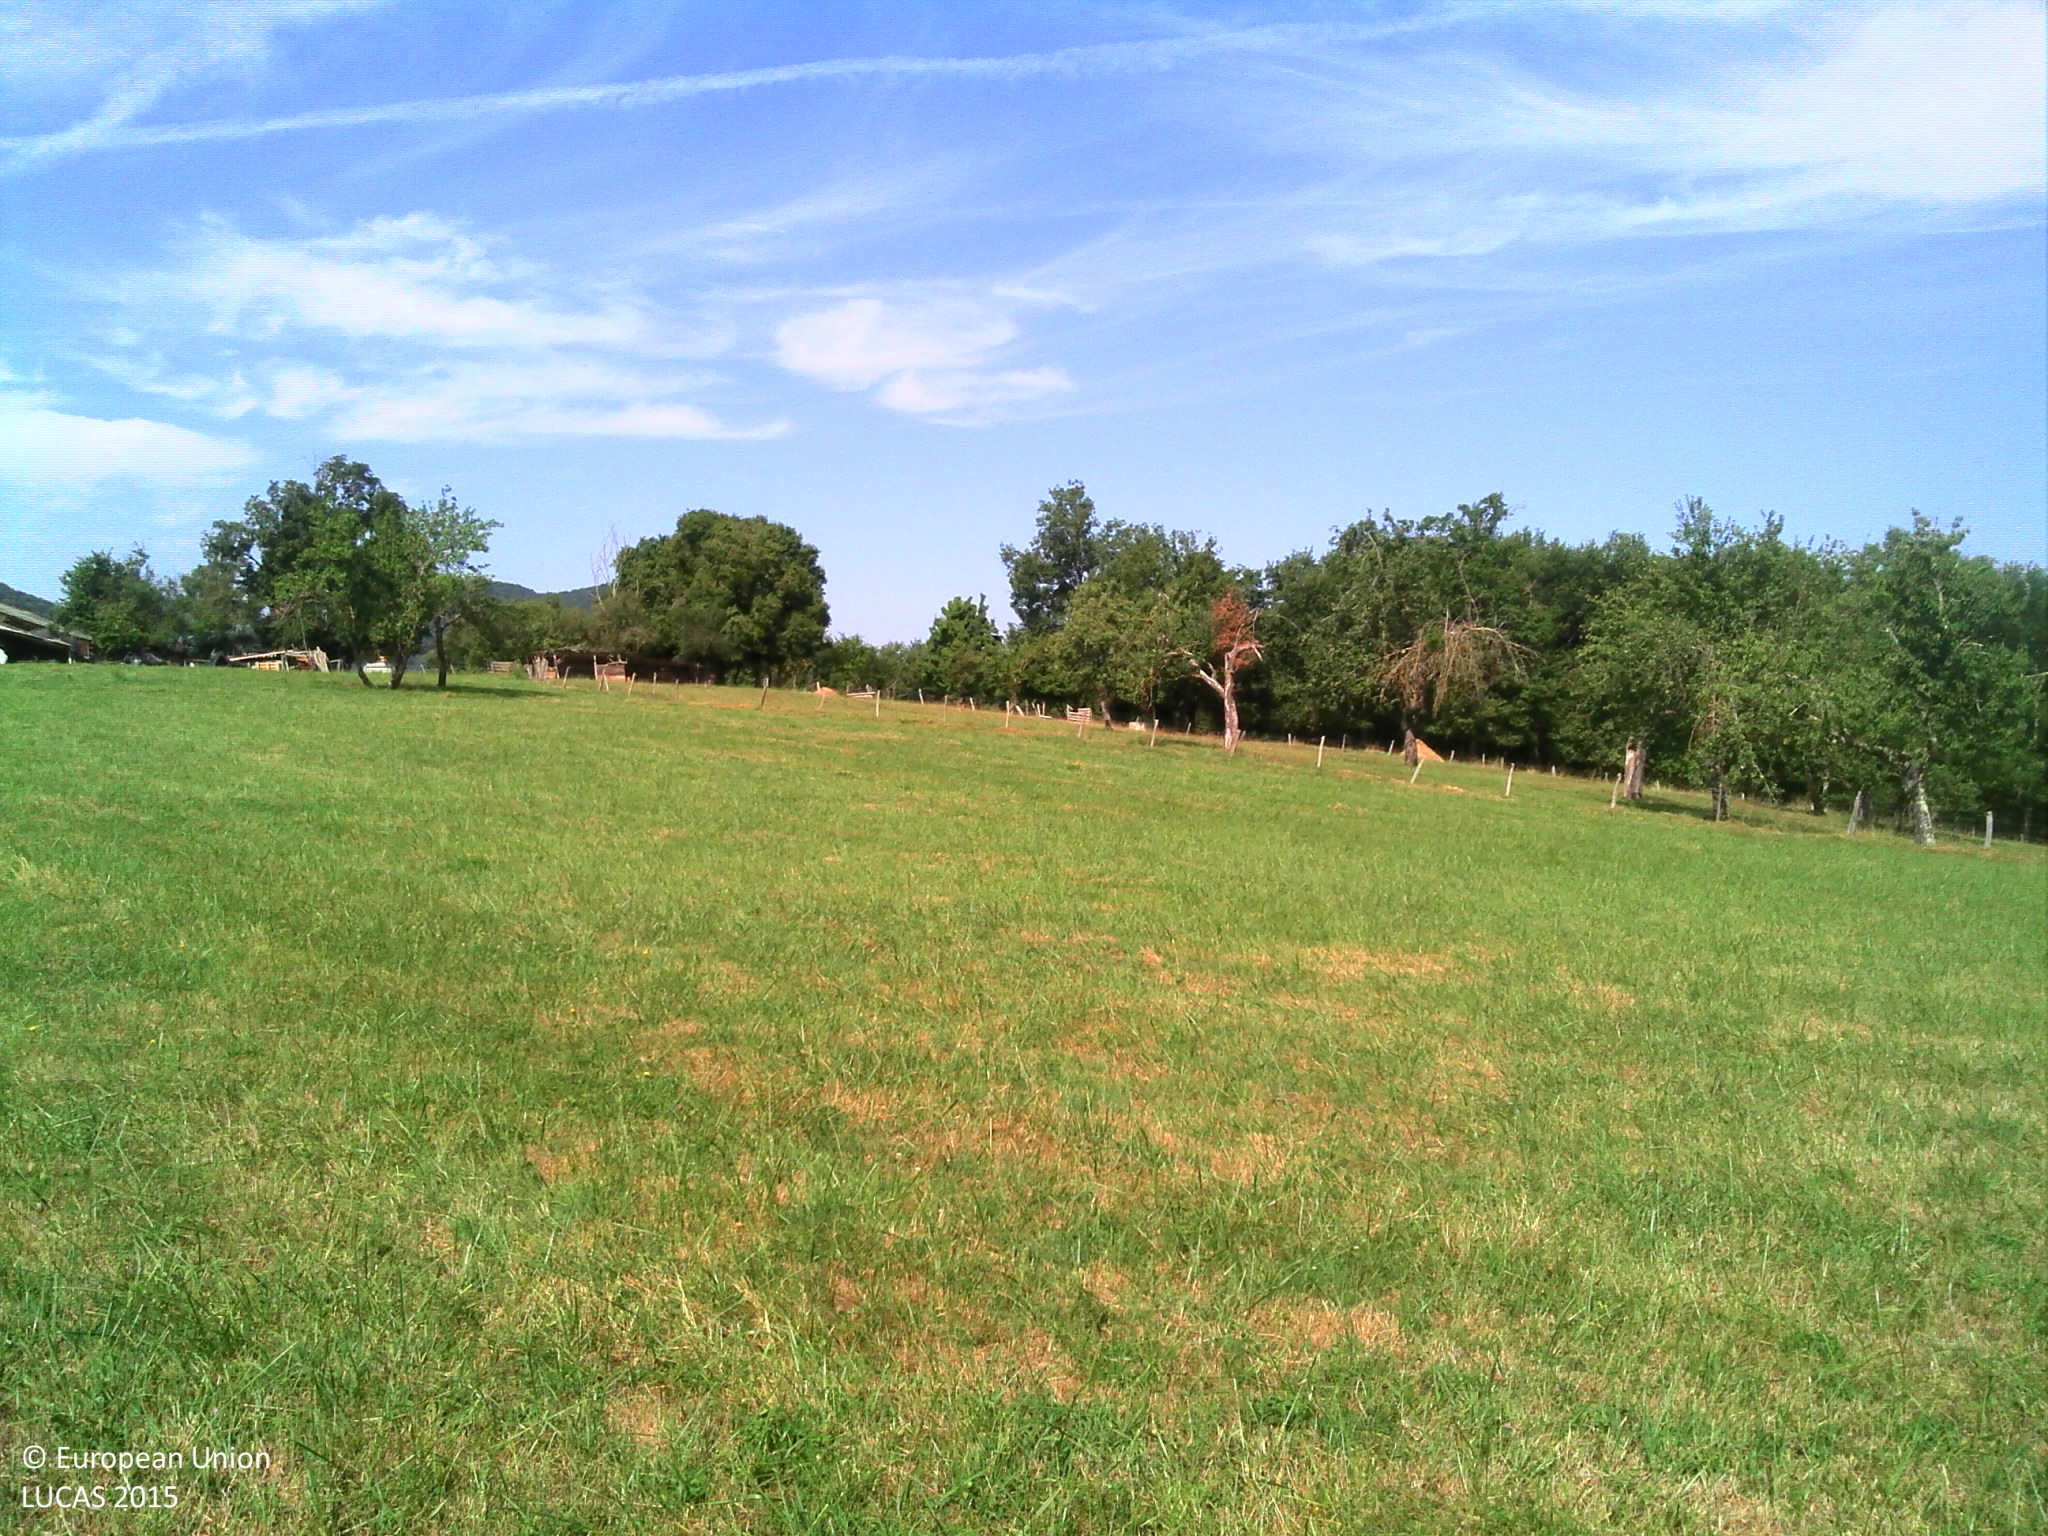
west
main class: Grassland
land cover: Grassland without tree/shrub cover
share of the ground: > 75 %
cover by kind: herbaceous plants 100 %
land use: Agriculture (excluding fallow land and kitchen gardens)
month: July
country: FR
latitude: 43.1658
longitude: 1.0613
